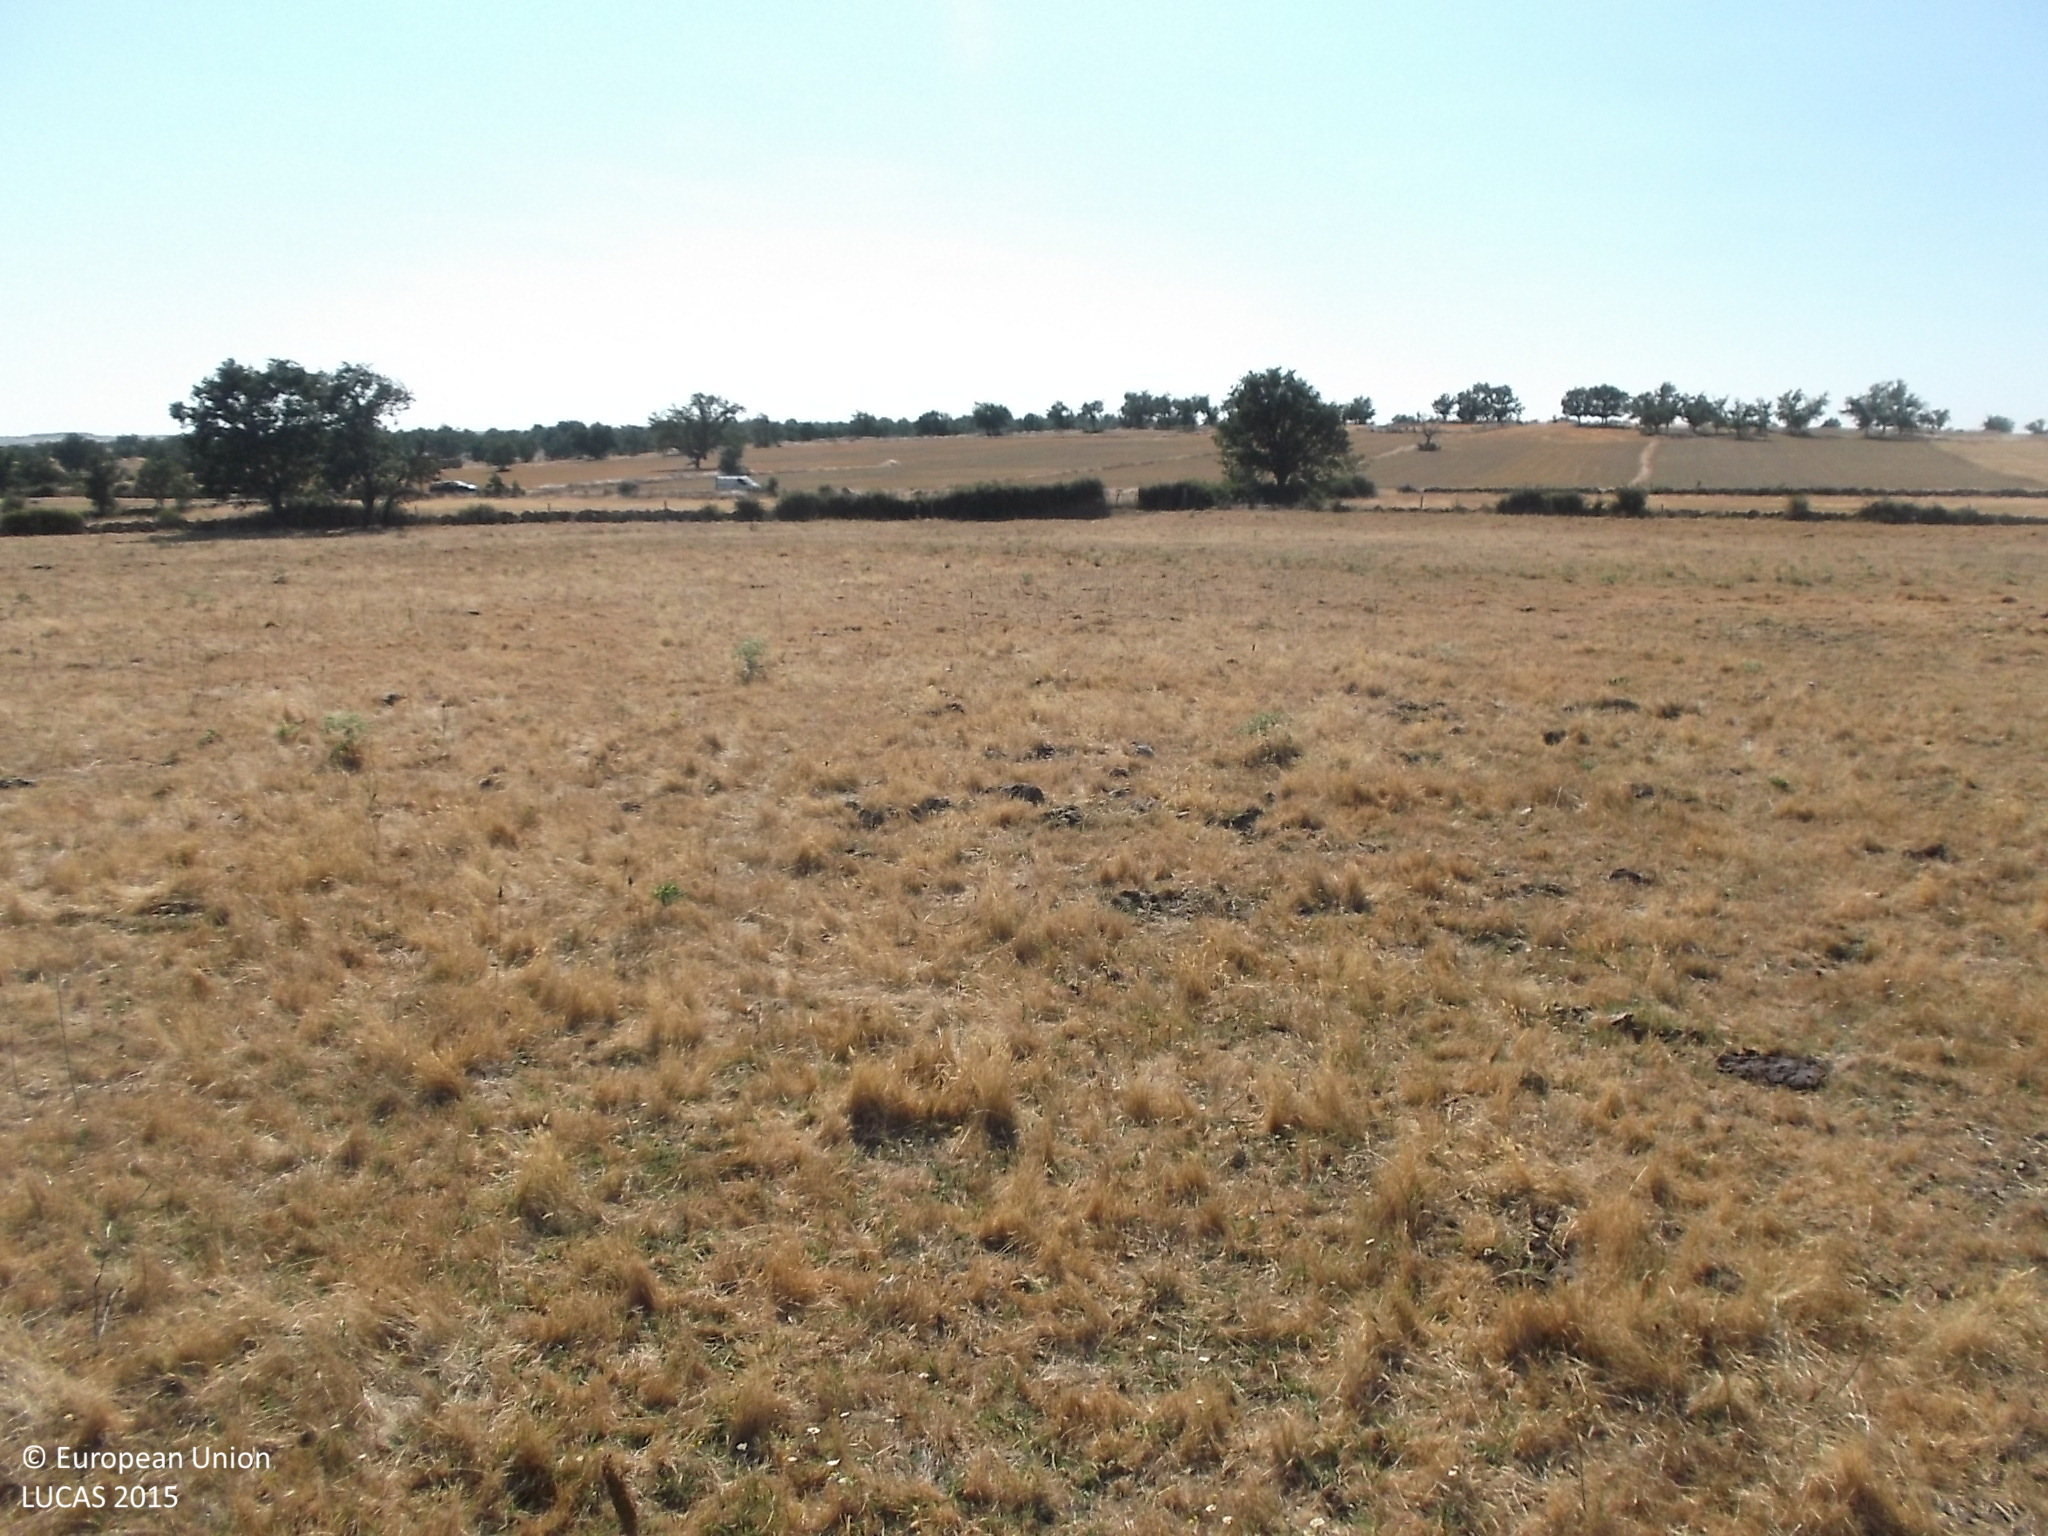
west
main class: Grassland
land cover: Grassland without tree/shrub cover
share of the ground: > 75 %
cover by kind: herbaceous plants 100 %
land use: Agriculture (excluding fallow land and kitchen gardens)
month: July
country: ES
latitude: 41.3014
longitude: -5.9848
